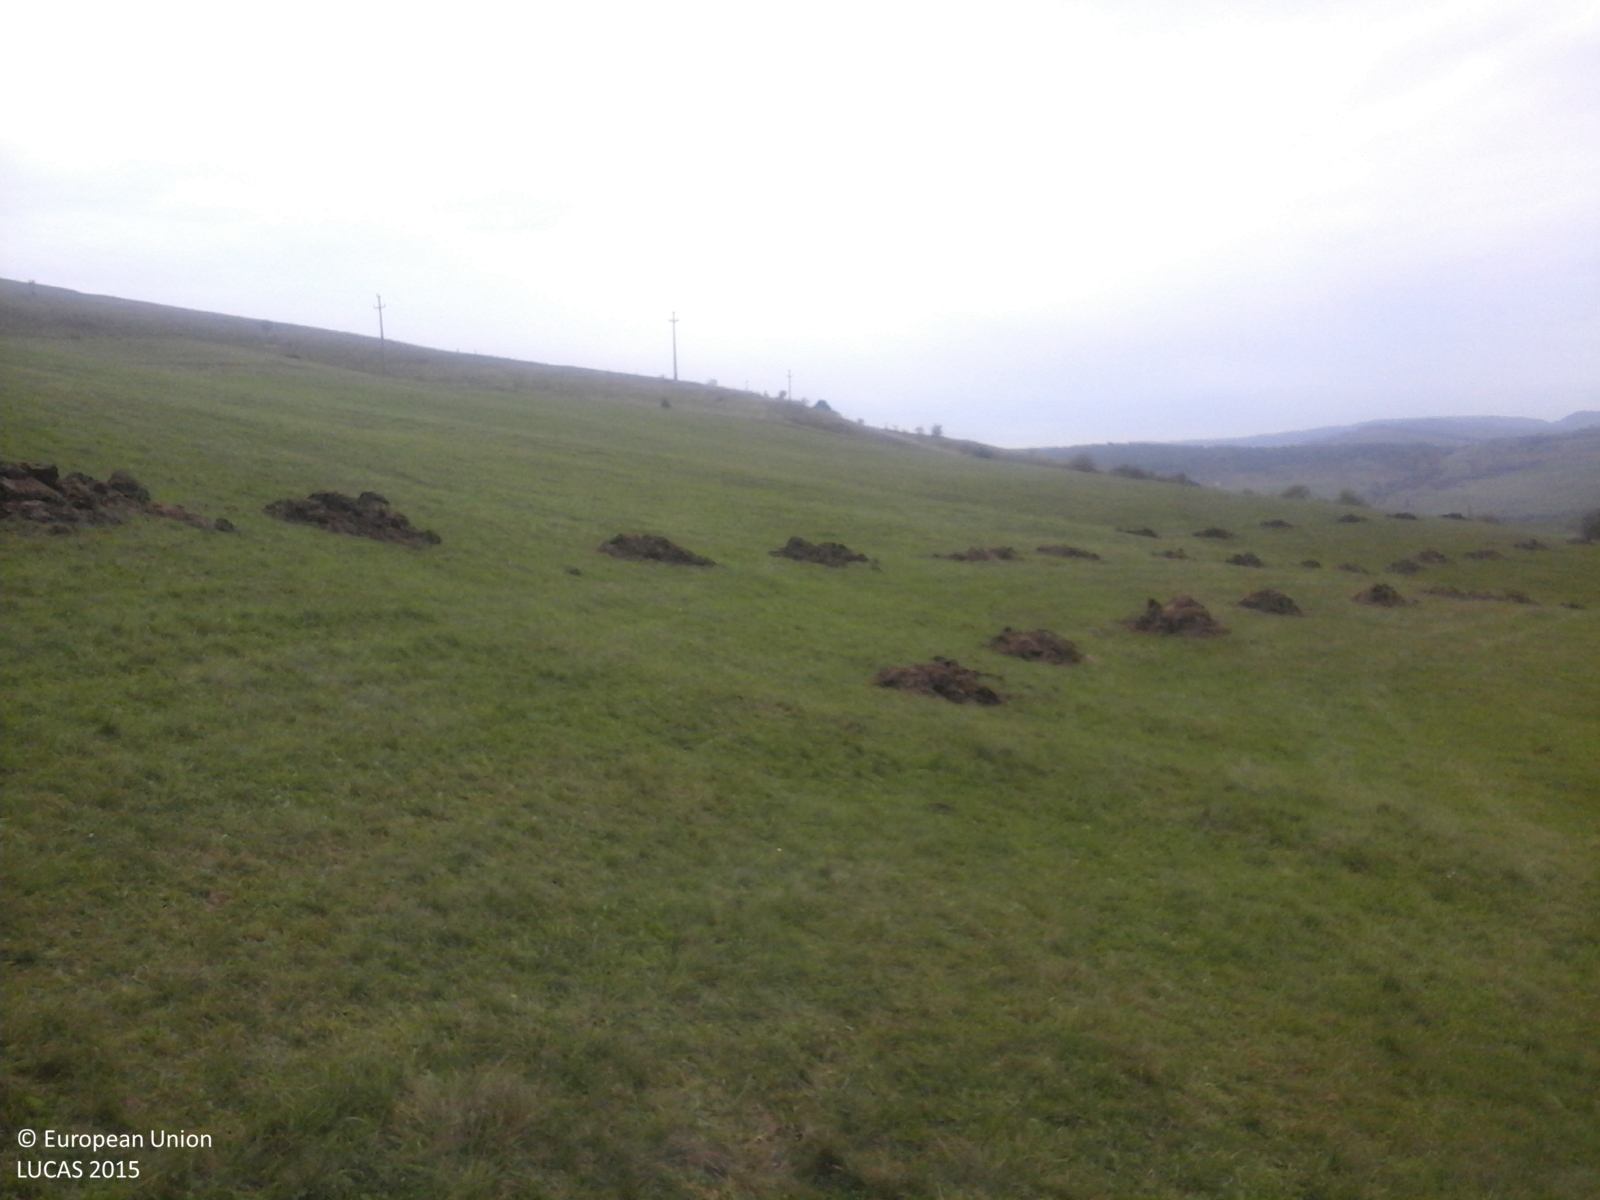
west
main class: Grassland
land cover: Grassland without tree/shrub cover
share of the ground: > 75 %
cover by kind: herbaceous plants 100 %
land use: Agriculture (excluding fallow land and kitchen gardens)
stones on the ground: < 10 %
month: October
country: RO
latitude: 46.2687
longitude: 25.2965
